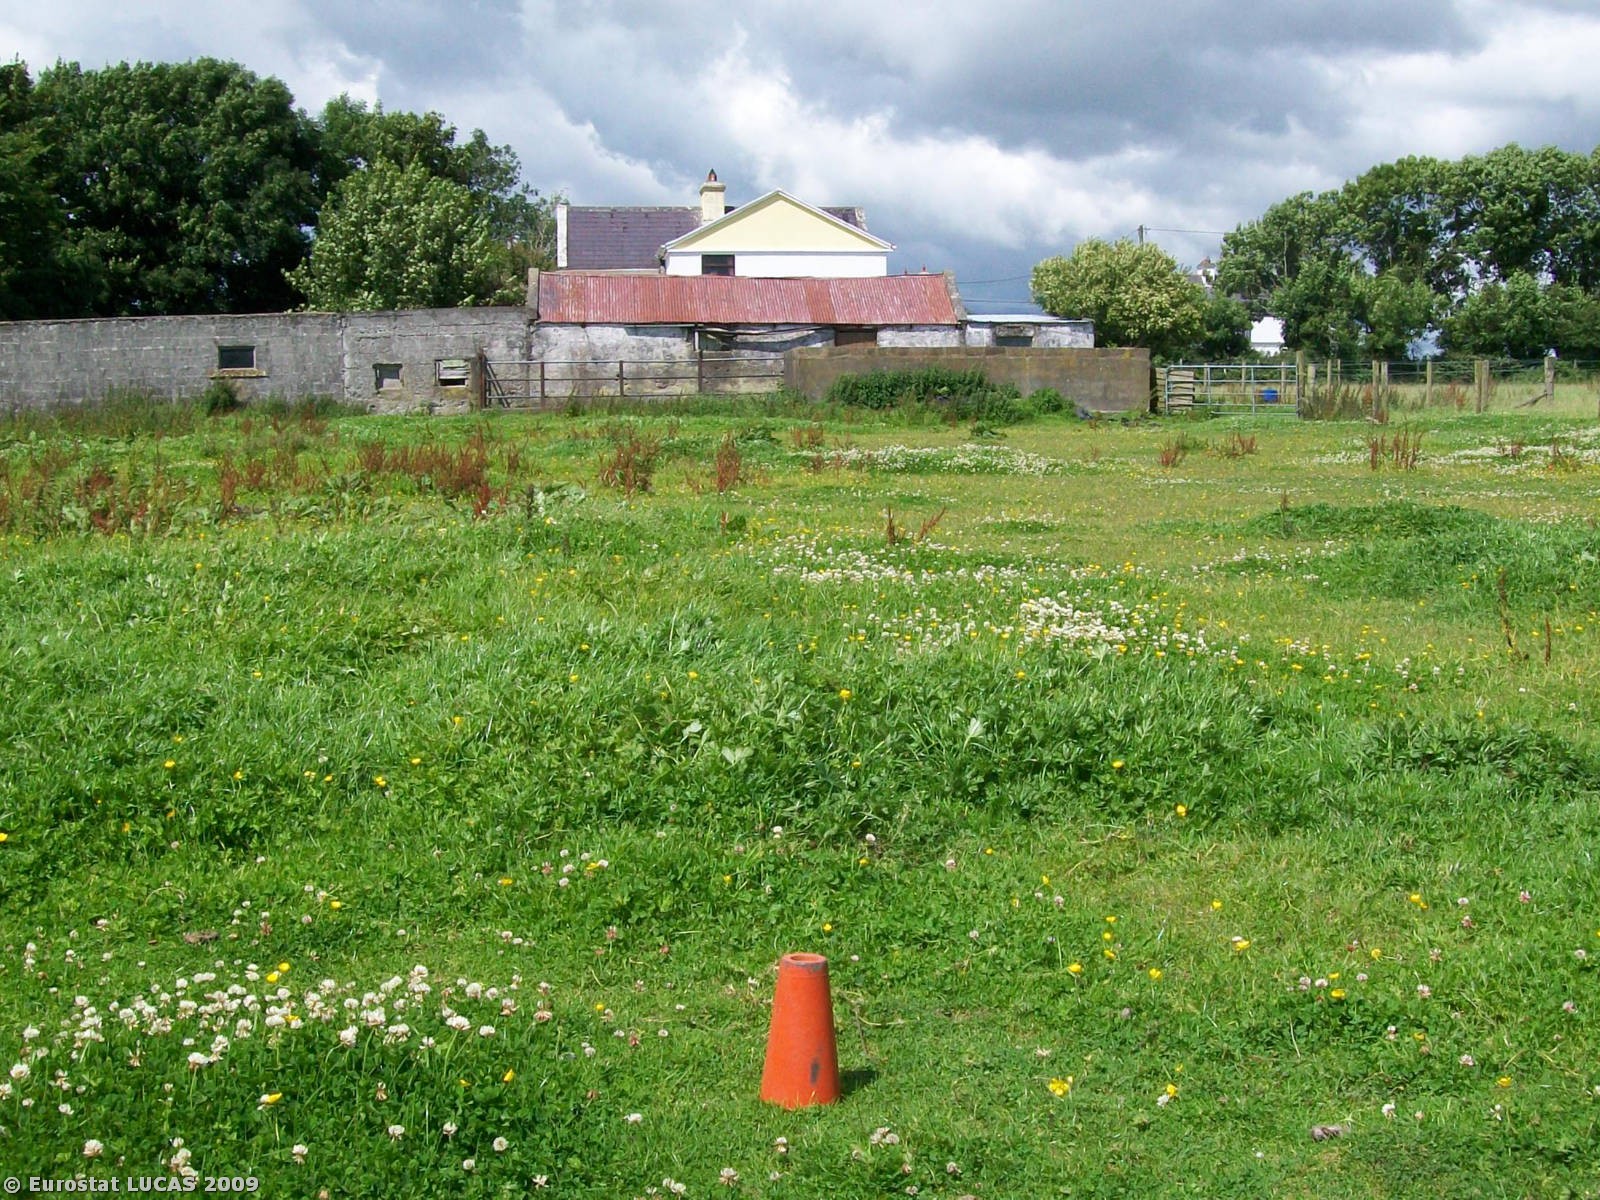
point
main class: Grassland
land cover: Grassland without tree/shrub cover
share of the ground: > 75 %
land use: Agriculture (excluding fallow land and kitchen gardens)
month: July
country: IE
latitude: 53.1592
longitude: -8.7325
